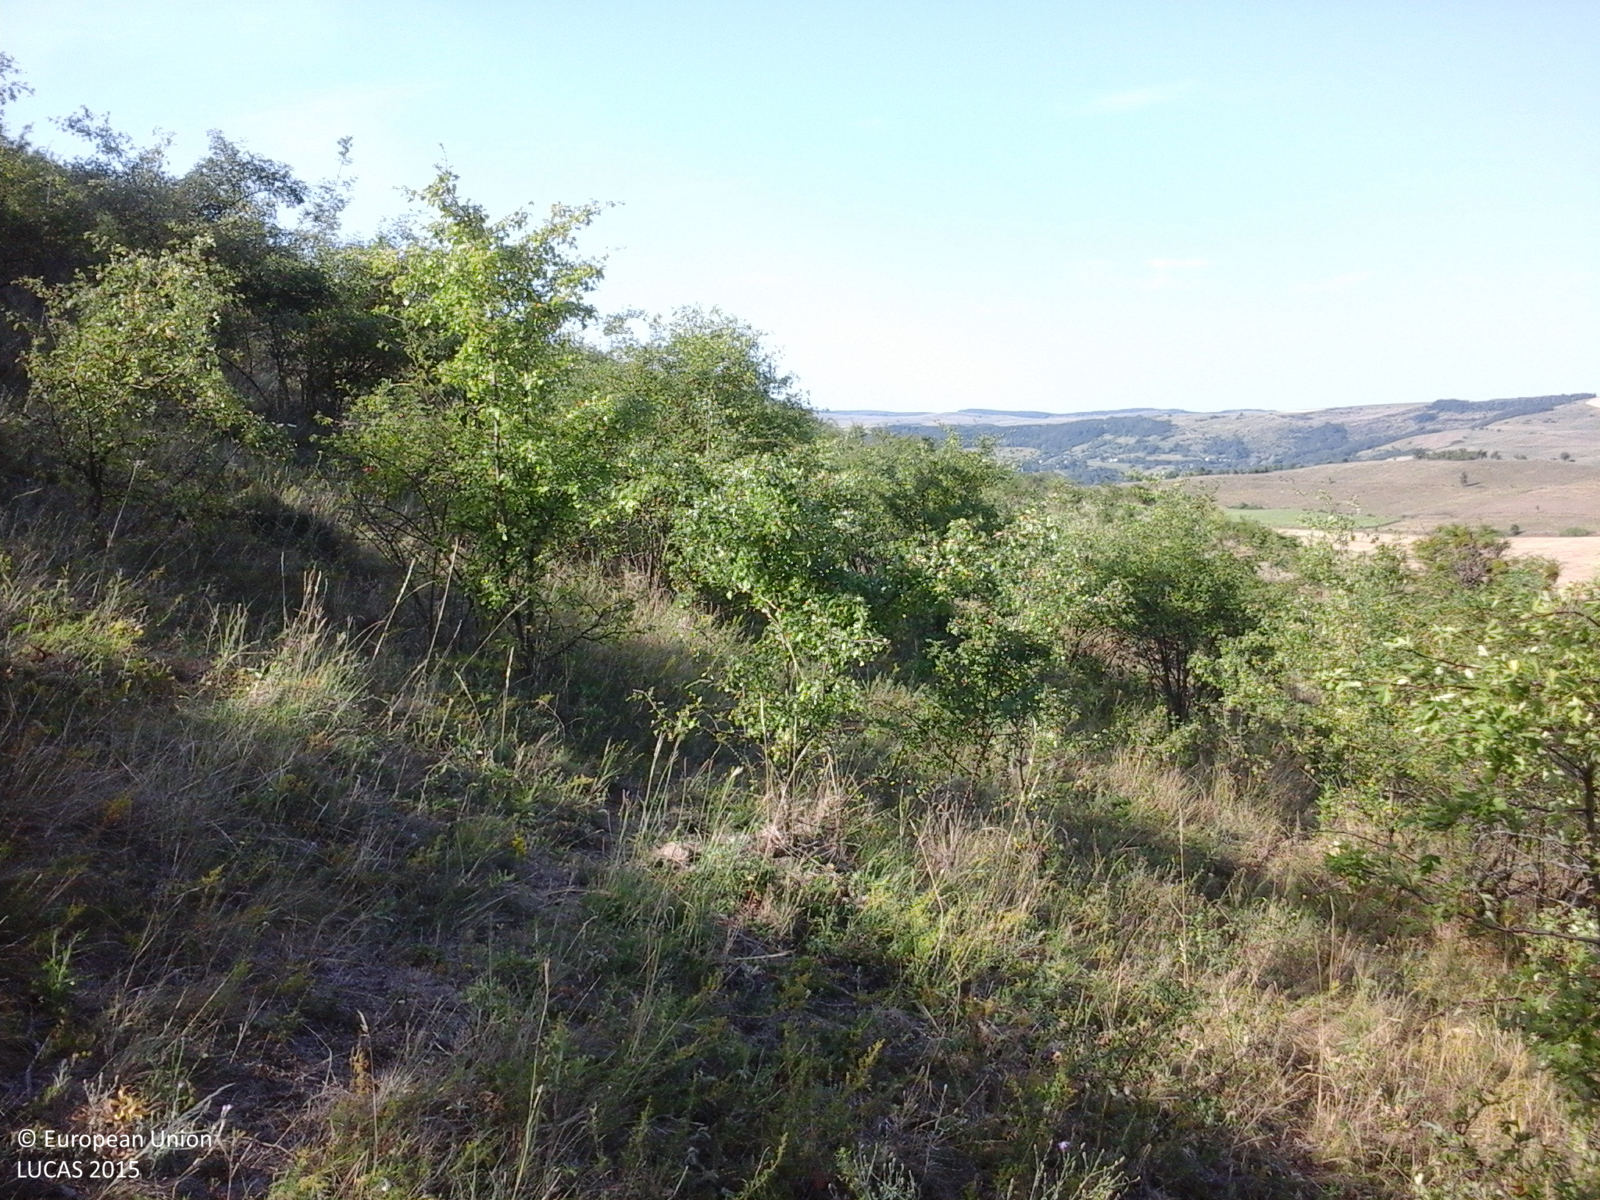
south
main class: Shrubland
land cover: Shrubland with sparse tree cover
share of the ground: > 75 %
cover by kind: herbaceous plants 75 %, shrubs 20 %, broadleaved forest trees 5 %
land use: Semi-natural and natural areas not in use
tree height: > 5 m
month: July
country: RO
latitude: 46.5628
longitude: 27.2047
